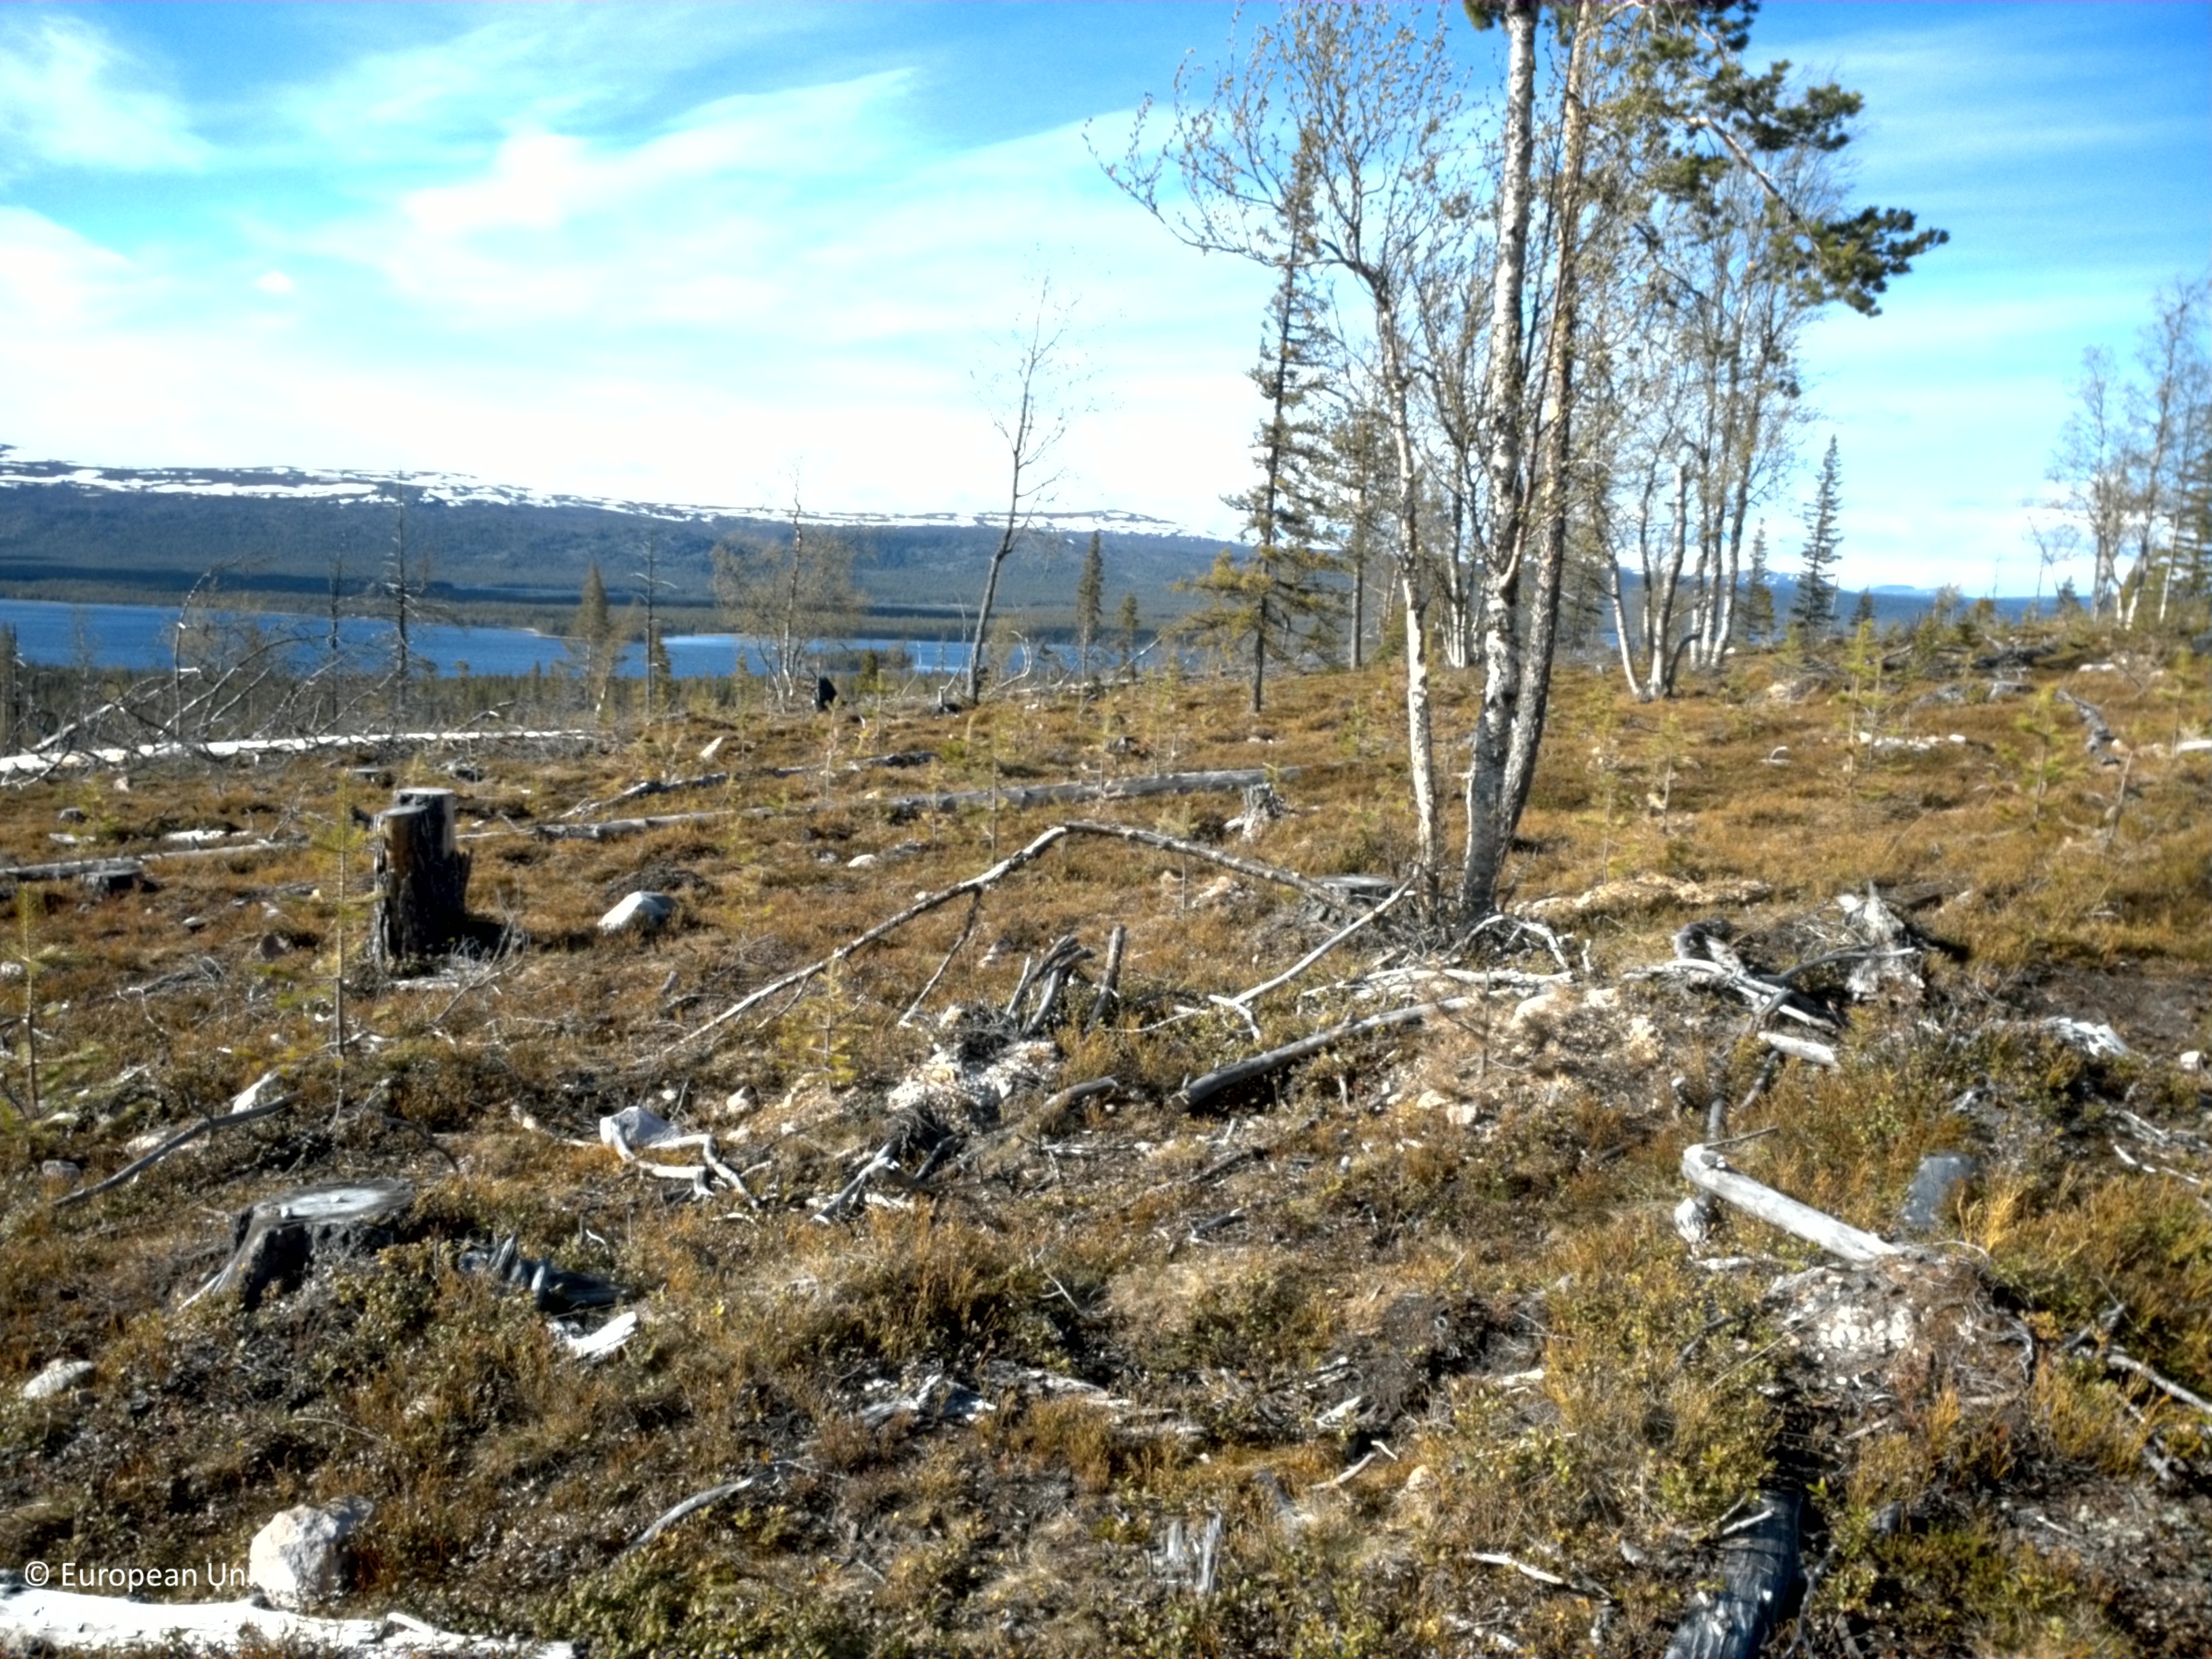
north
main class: Shrubland
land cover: Shrubland with sparse tree cover
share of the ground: > 75 %
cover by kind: shrubs 90 %, coniferous forest trees 5 %, consolidated bare surface 5 %
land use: Forestry
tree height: < 5 m
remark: Clear cut
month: June
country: SE
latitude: 66.3821
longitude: 18.2956
